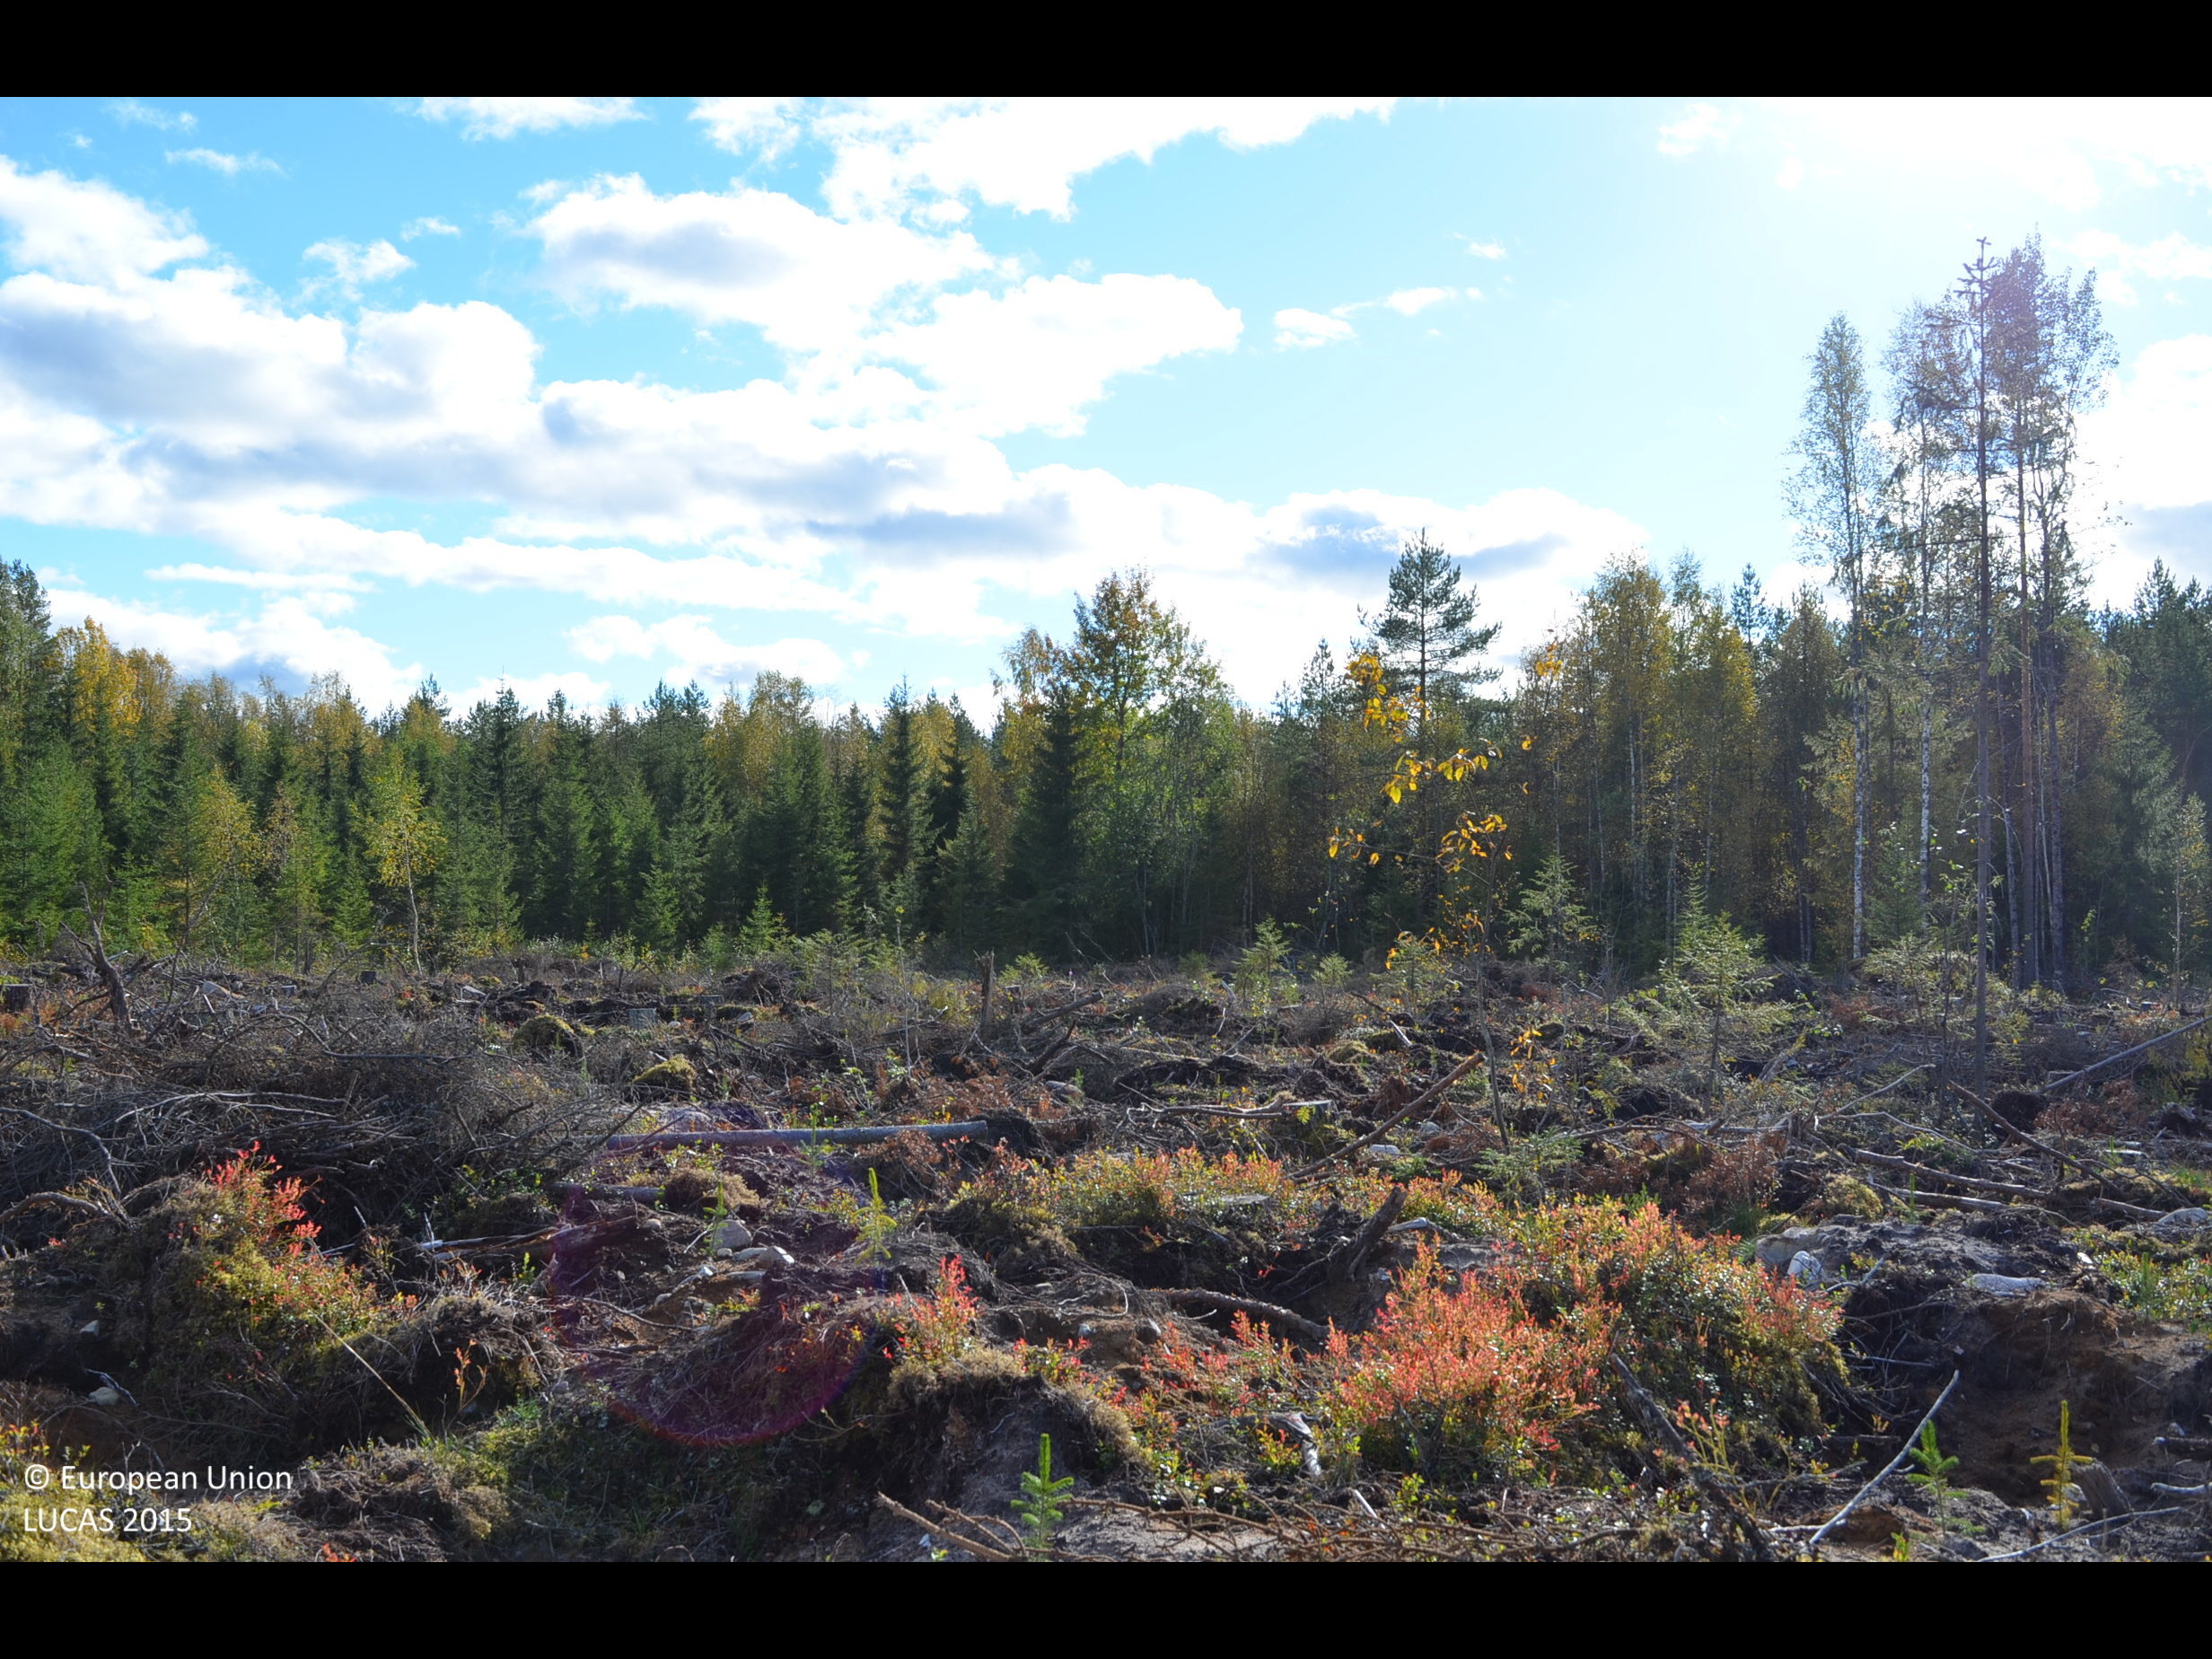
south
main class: Shrubland
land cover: Shrubland without tree cover
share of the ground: 10 - 25 %
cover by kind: unconsolidated bare surface 50 %, shrubs 10 %, lichens and mosses 10 %
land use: Forestry
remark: Clear cut
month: September
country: FI
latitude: 62.9066
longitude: 23.8301
